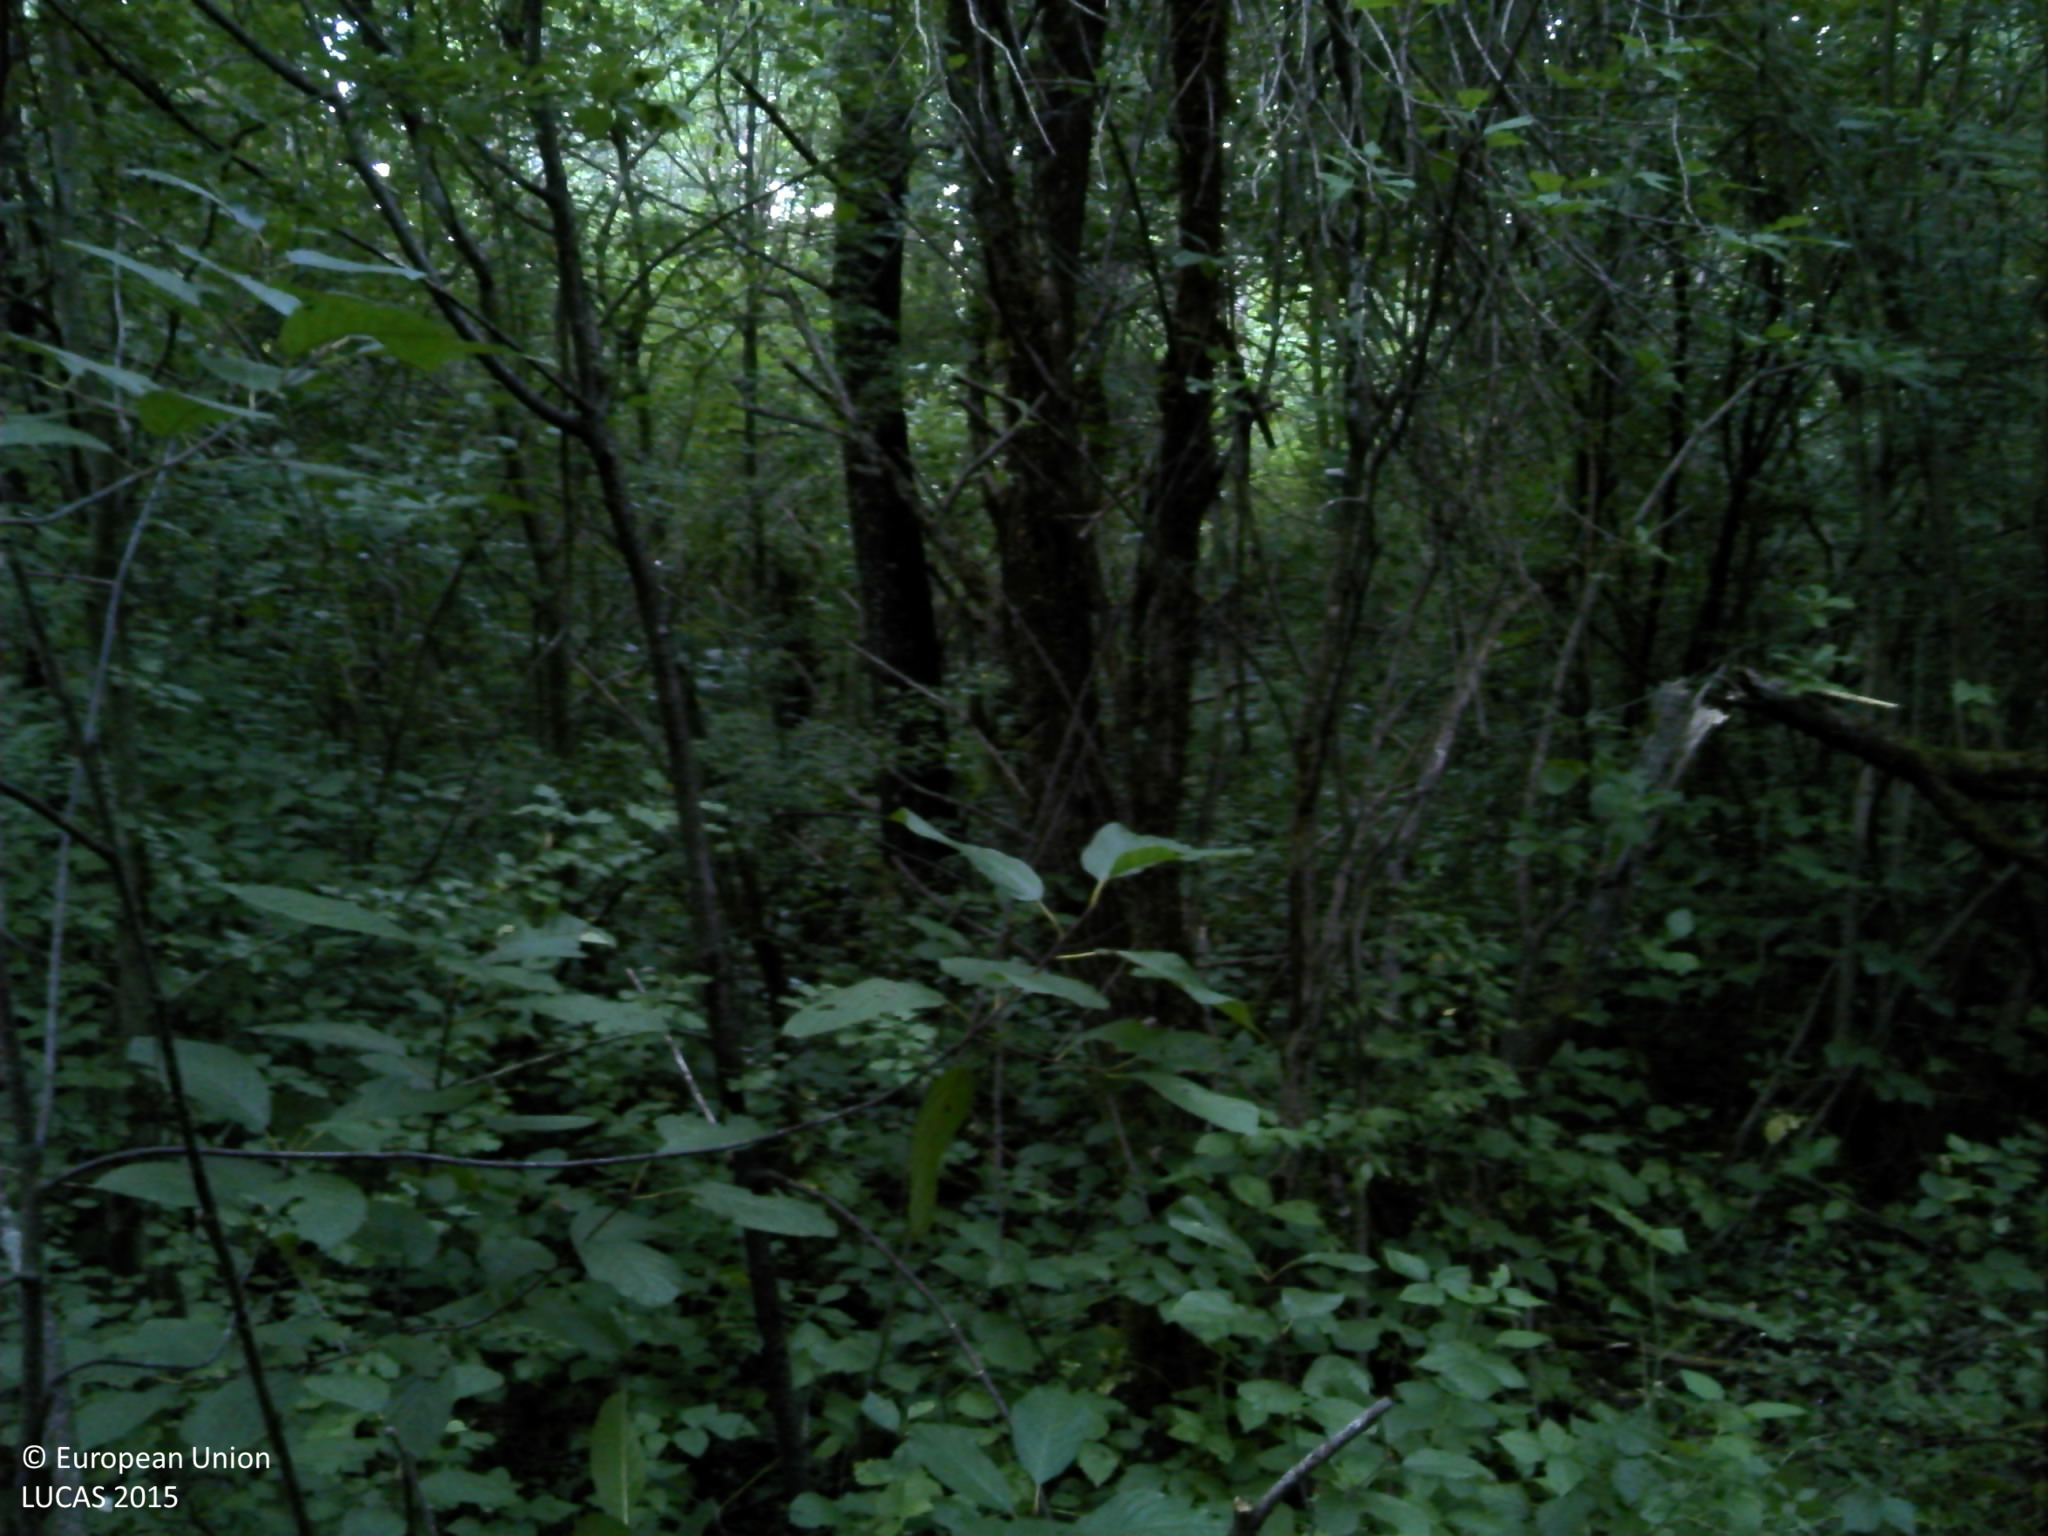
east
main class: Shrubland
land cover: Shrubland with sparse tree cover
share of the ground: > 75 %
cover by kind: shrubs 95 %, broadleaved forest trees 5 %
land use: Semi-natural and natural areas not in use
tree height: < 5 m
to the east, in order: Shrubland with sparse tree cover
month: August
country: HR
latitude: 45.4288
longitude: 16.5294
